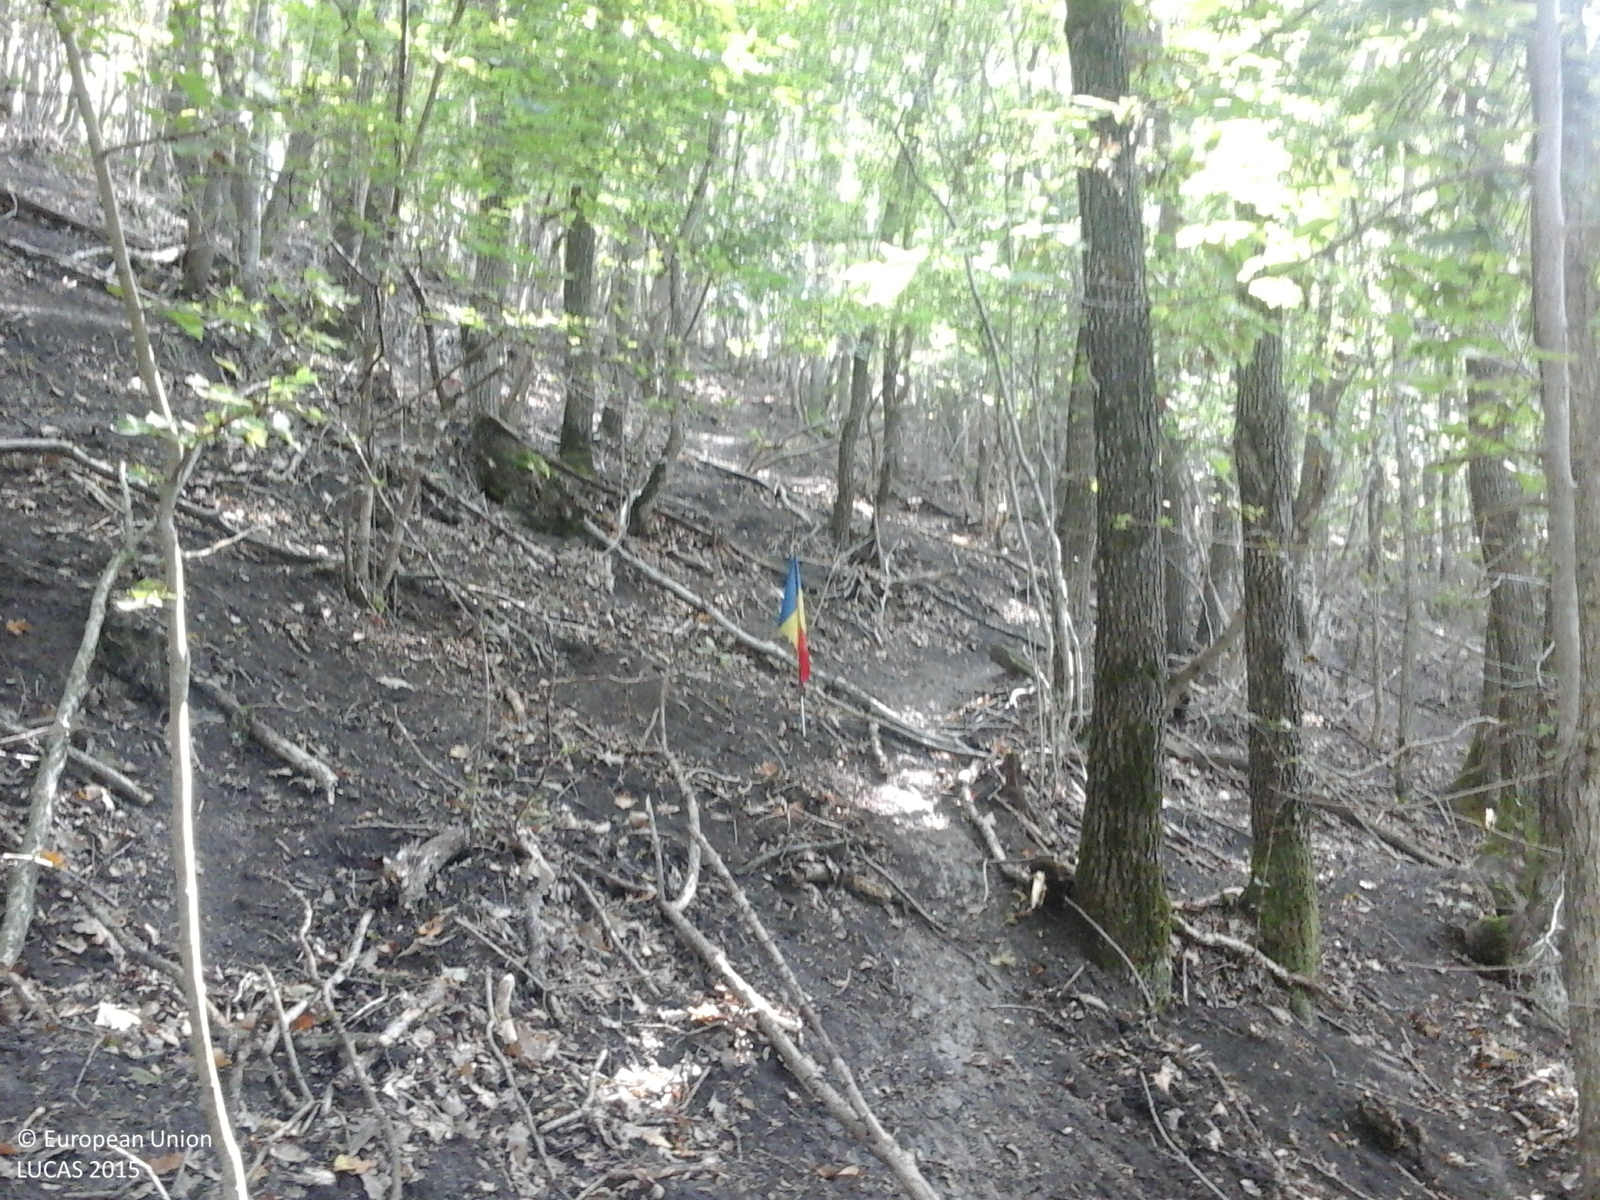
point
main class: Woodland
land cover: Broadleaved woodland
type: acidophilous oak and oak-birch forest
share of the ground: > 75 %
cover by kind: broadleaved forest trees 100 %
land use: Forestry
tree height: > 5 m
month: September
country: RO
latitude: 47.0883
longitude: 23.7090
